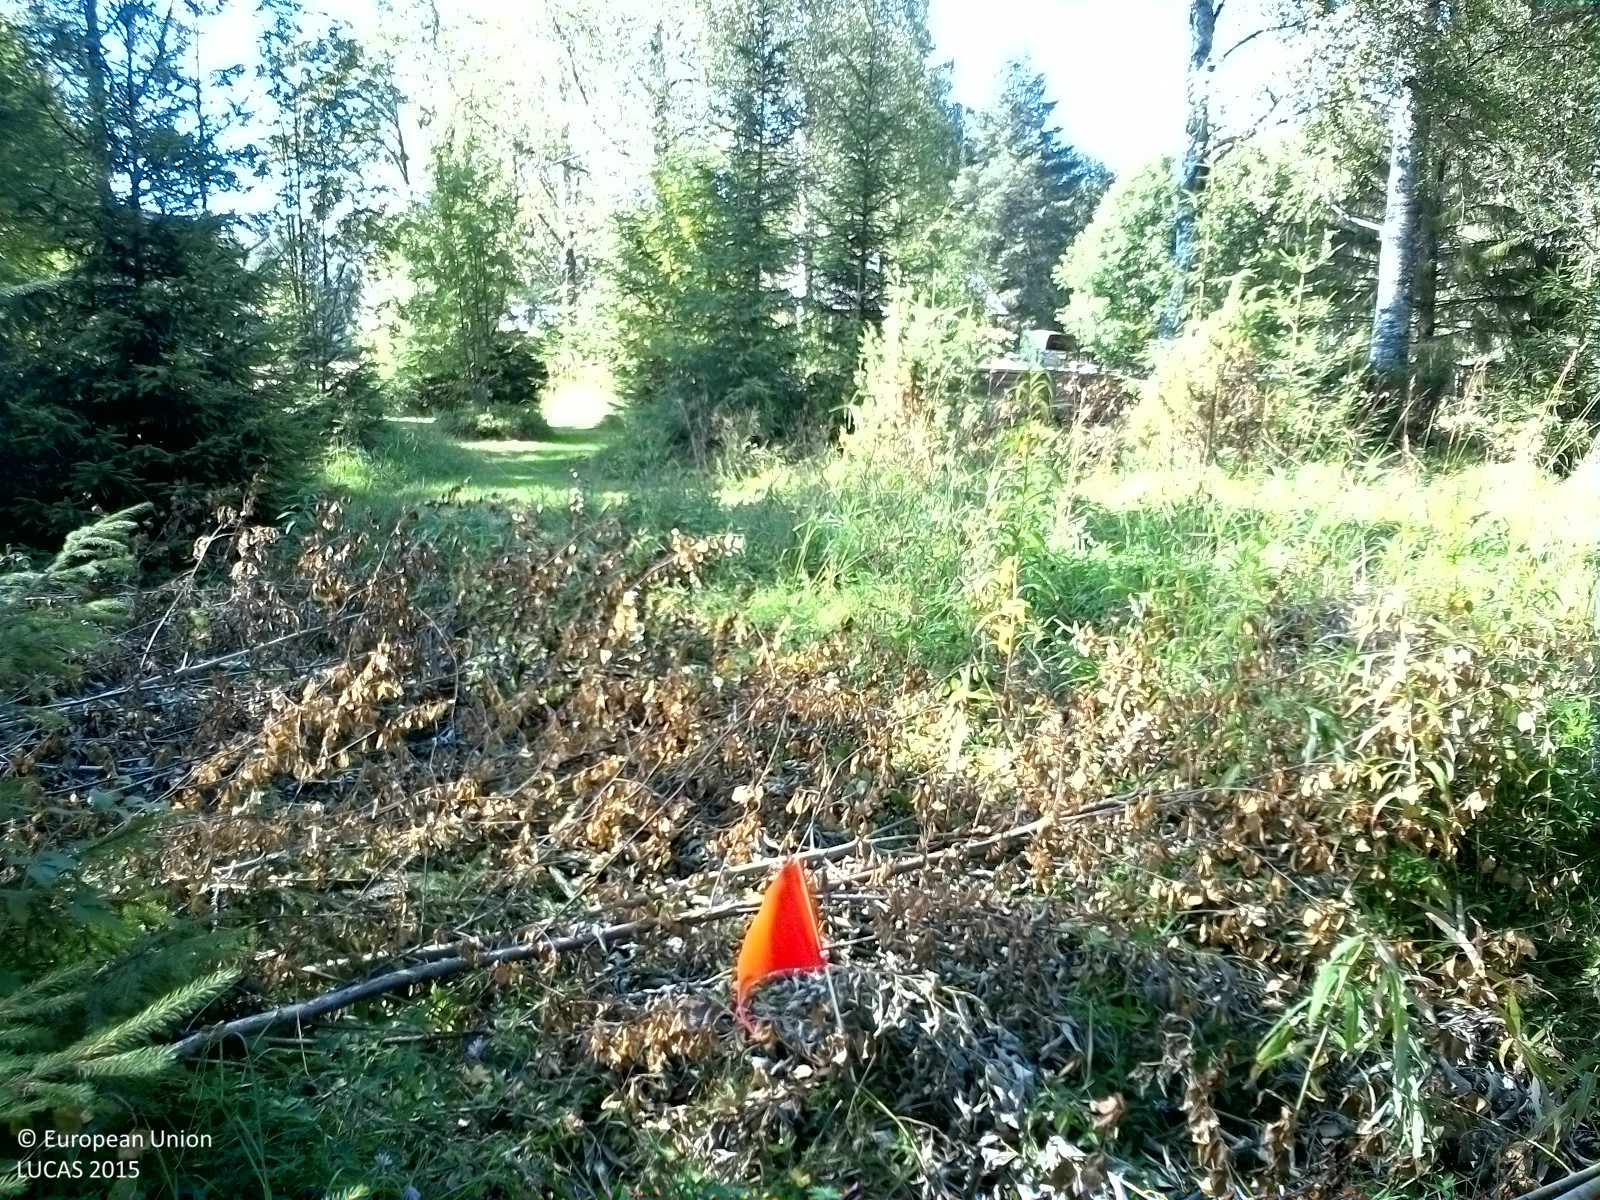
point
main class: Woodland
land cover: Spruce dominated mixed woodland
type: boreal forest
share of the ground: 50 - 75 %
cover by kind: coniferous forest trees 40 %, herbaceous plants 40 %, broadleaved forest trees 15 %
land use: Forestry
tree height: > 5 m
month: August
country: SE
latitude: 62.4039
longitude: 16.8105
